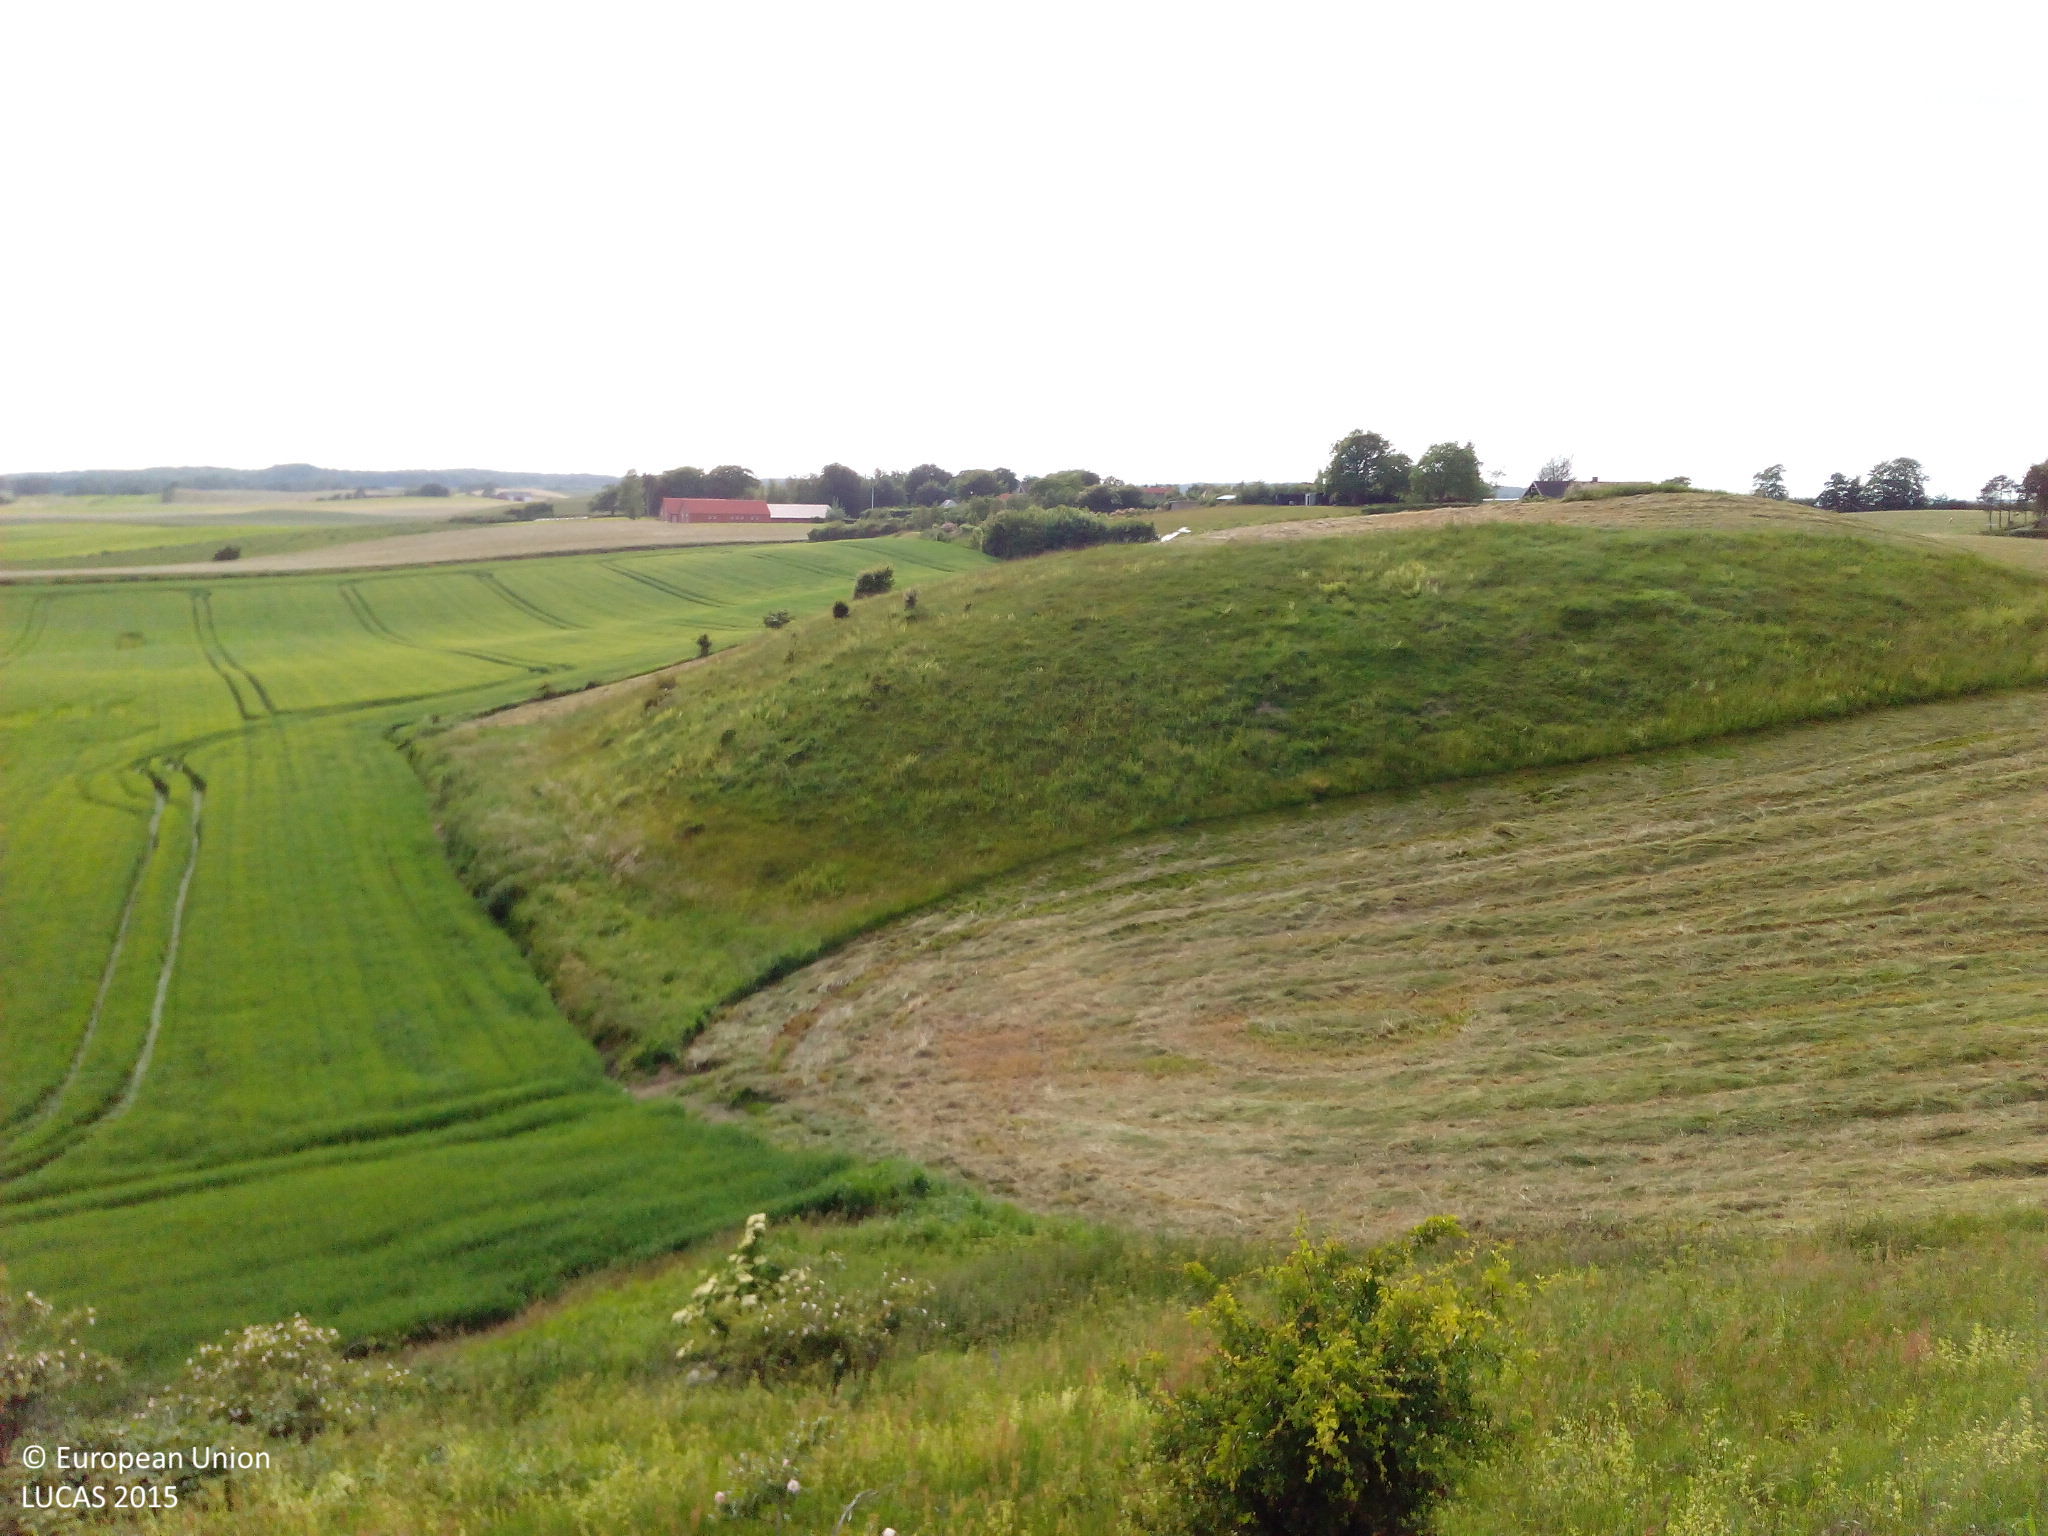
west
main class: Grassland
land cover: Grassland without tree/shrub cover
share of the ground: > 75 %
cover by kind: herbaceous plants 100 %
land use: Semi-natural and natural areas not in use
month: June
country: DK
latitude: 56.2394
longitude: 10.7574
